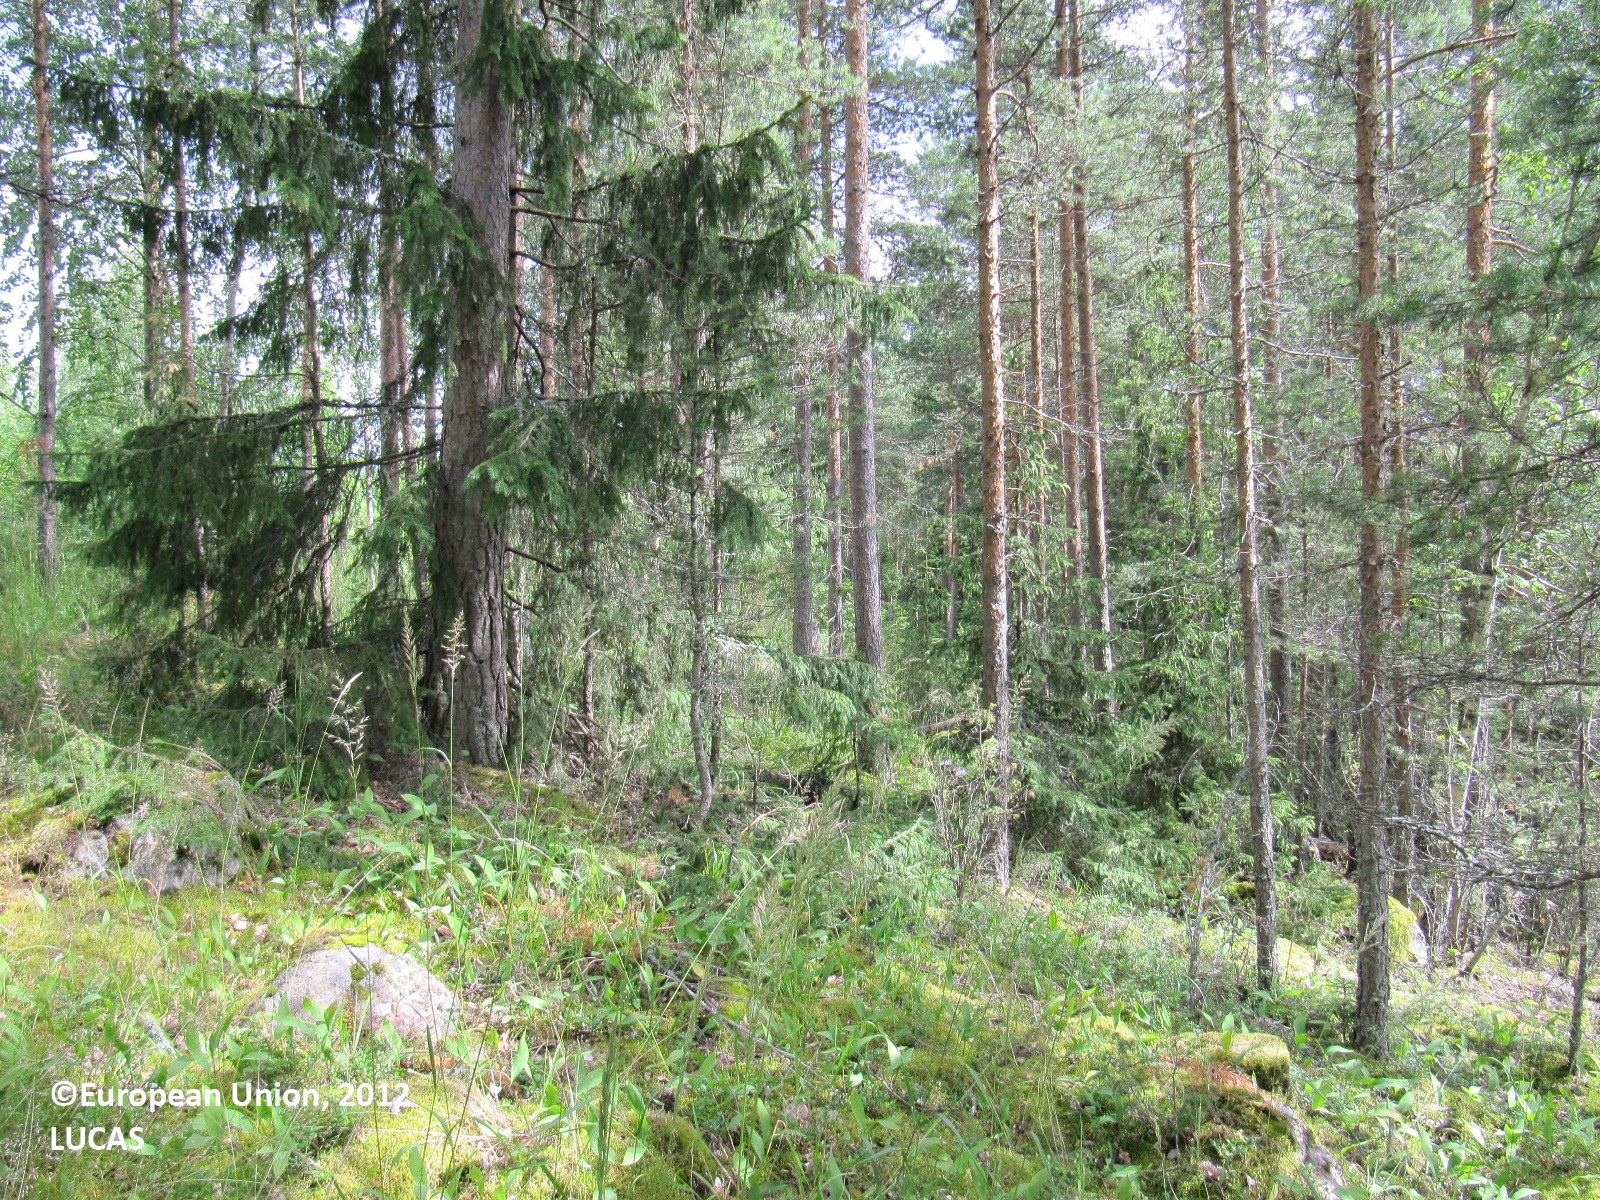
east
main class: Woodland
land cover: Pine dominated mixed woodland
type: boreal forest
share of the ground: 50 - 75 %
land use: Forestry
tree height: > 5 m
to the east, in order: Pine dominated mixed woodland; Broadleaved woodland
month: July
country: FI
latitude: 60.7533
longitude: 24.6209
